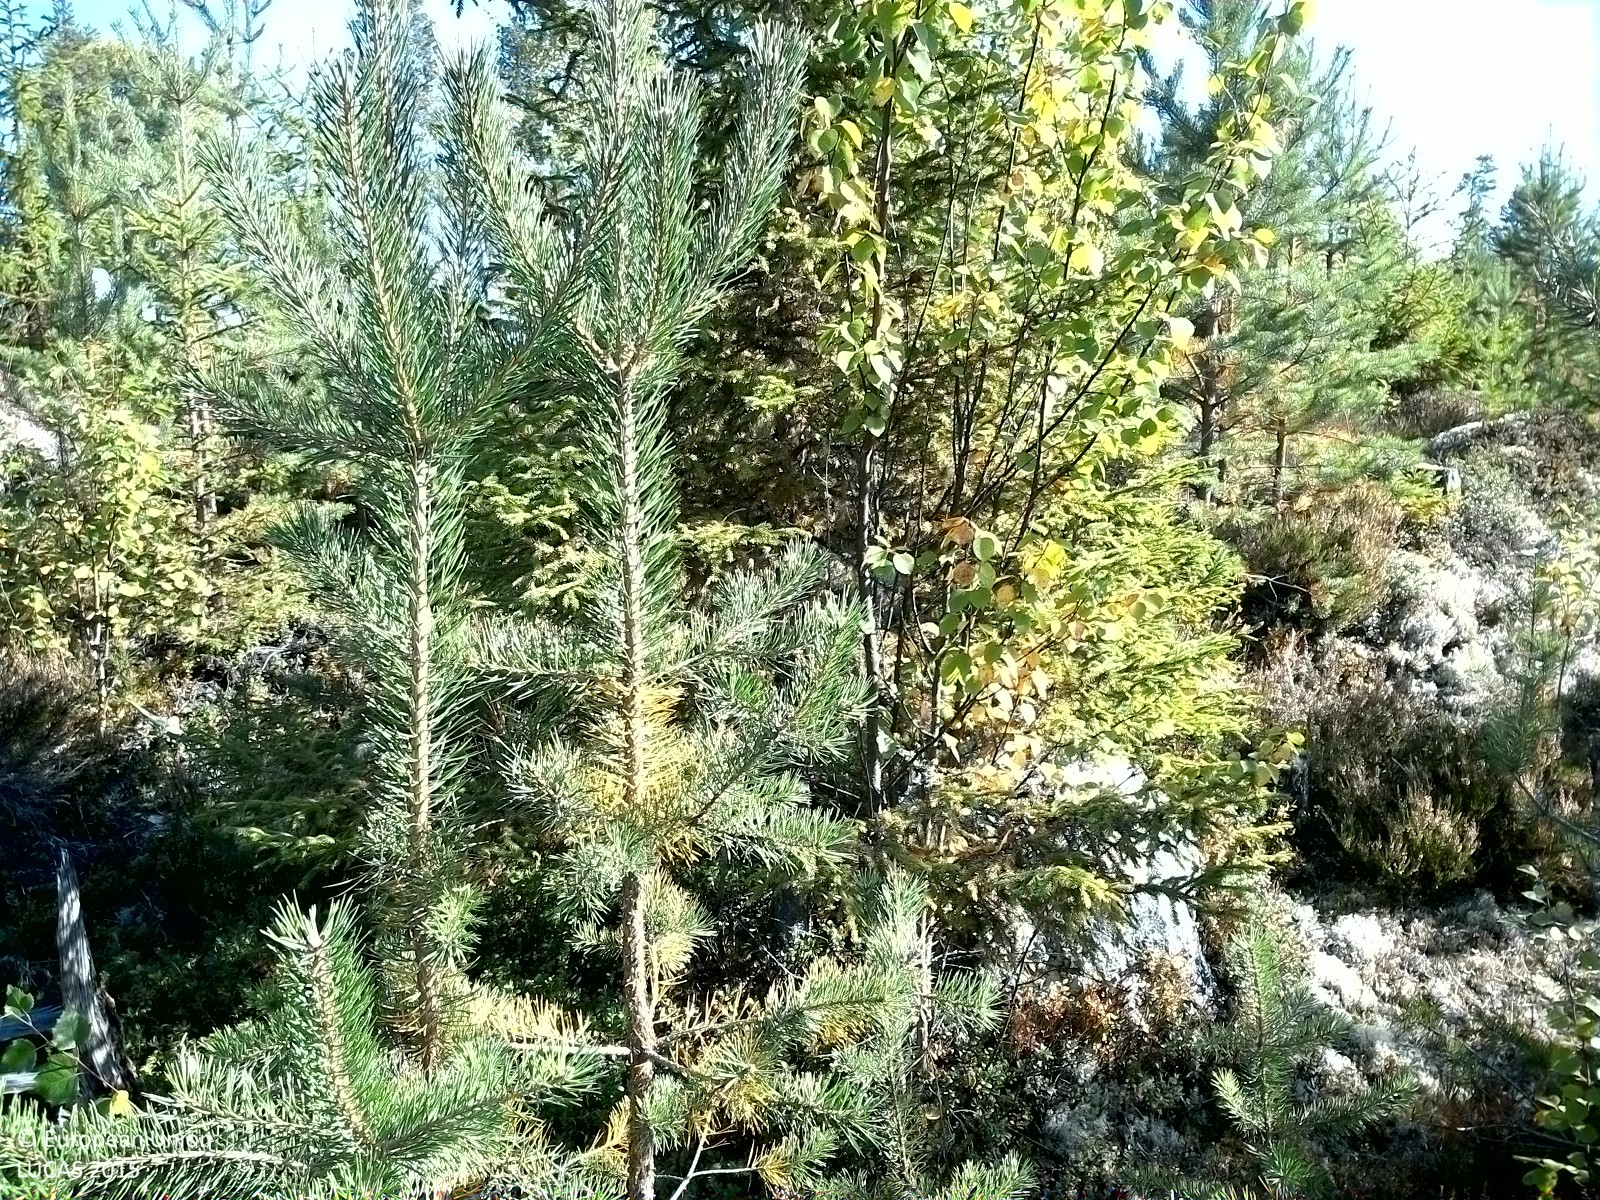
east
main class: Woodland
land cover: Other mixed woodland
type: boreal forest
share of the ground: 50 - 75 %
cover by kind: coniferous forest trees 40 %, broadleaved forest trees 20 %, shrubs 20 %, lichens and mosses 20 %
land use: Forestry
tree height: < 5 m
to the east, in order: Other mixed woodland; Spruce dominated mixed woodland; Other mixed woodland
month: September
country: SE
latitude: 62.5577
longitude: 16.1835
